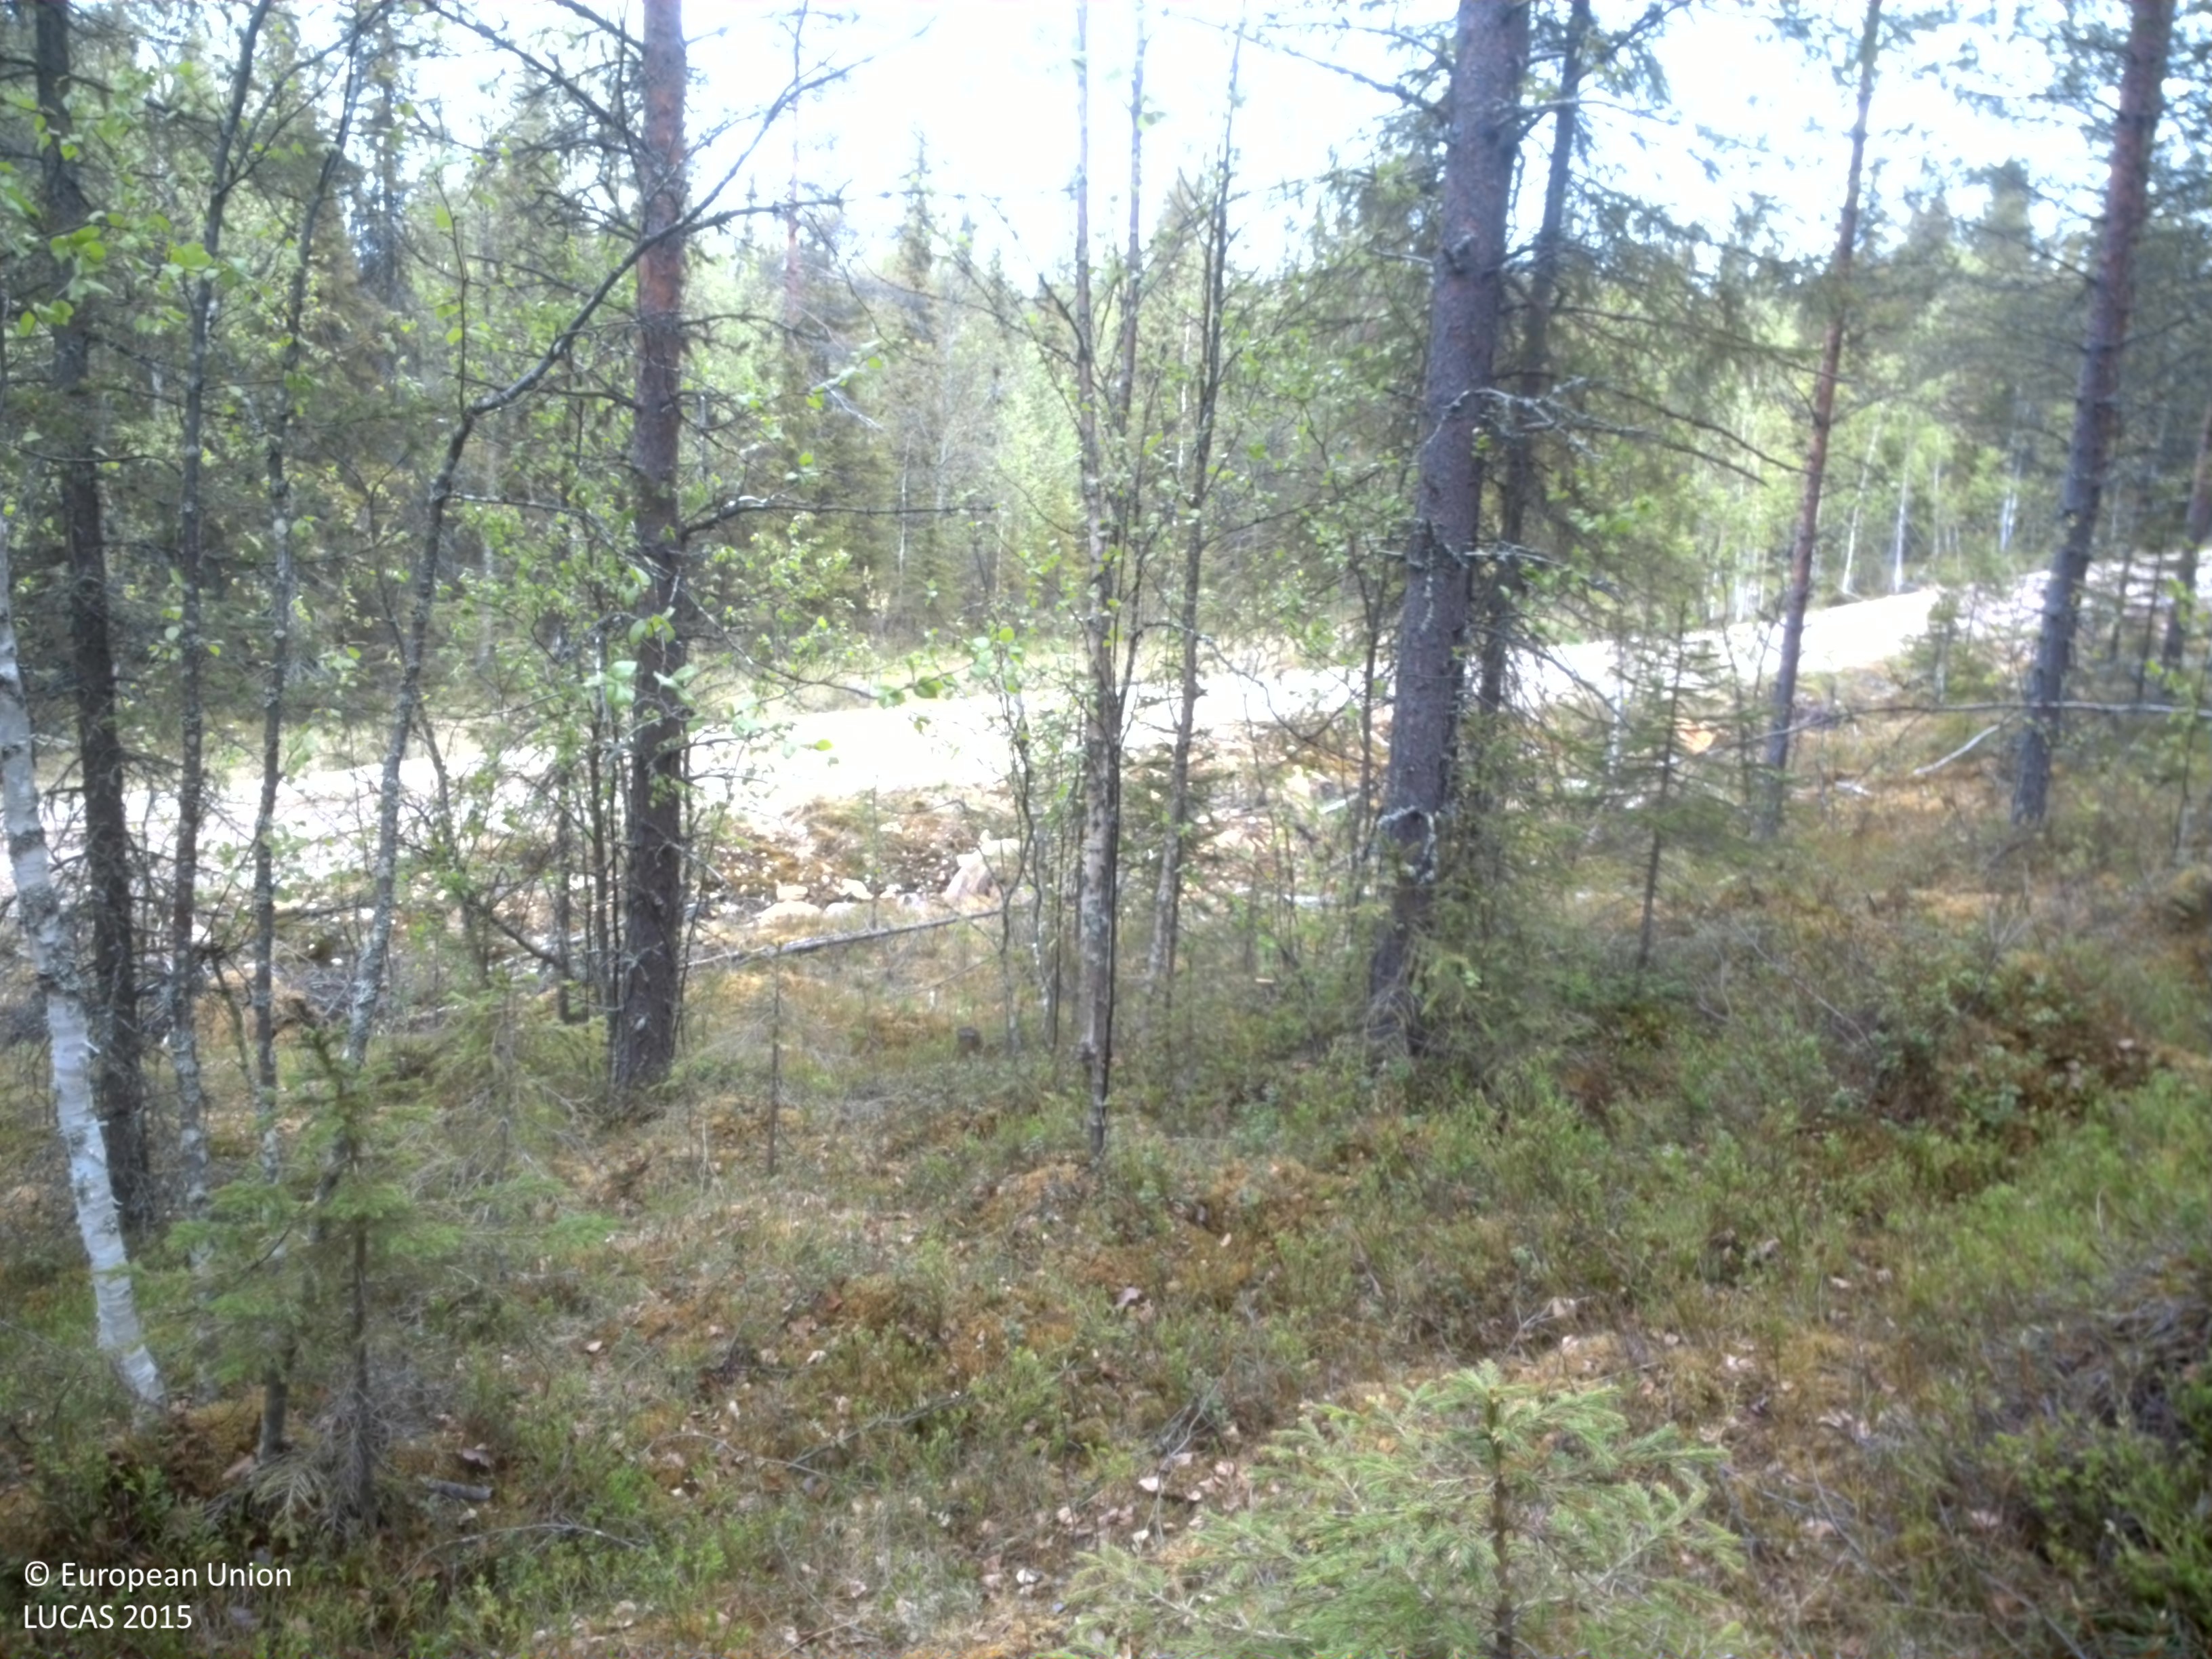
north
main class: Woodland
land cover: Pine dominated mixed woodland
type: boreal forest
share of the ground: 25 - 50 %
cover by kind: herbaceous plants 40 %, coniferous forest trees 25 %, lichens and mosses 15 %, broadleaved forest trees 10 %, shrubs 10 %
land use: Forestry
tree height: > 5 m
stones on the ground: < 10 %
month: June
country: SE
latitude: 66.6990
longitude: 22.4056
